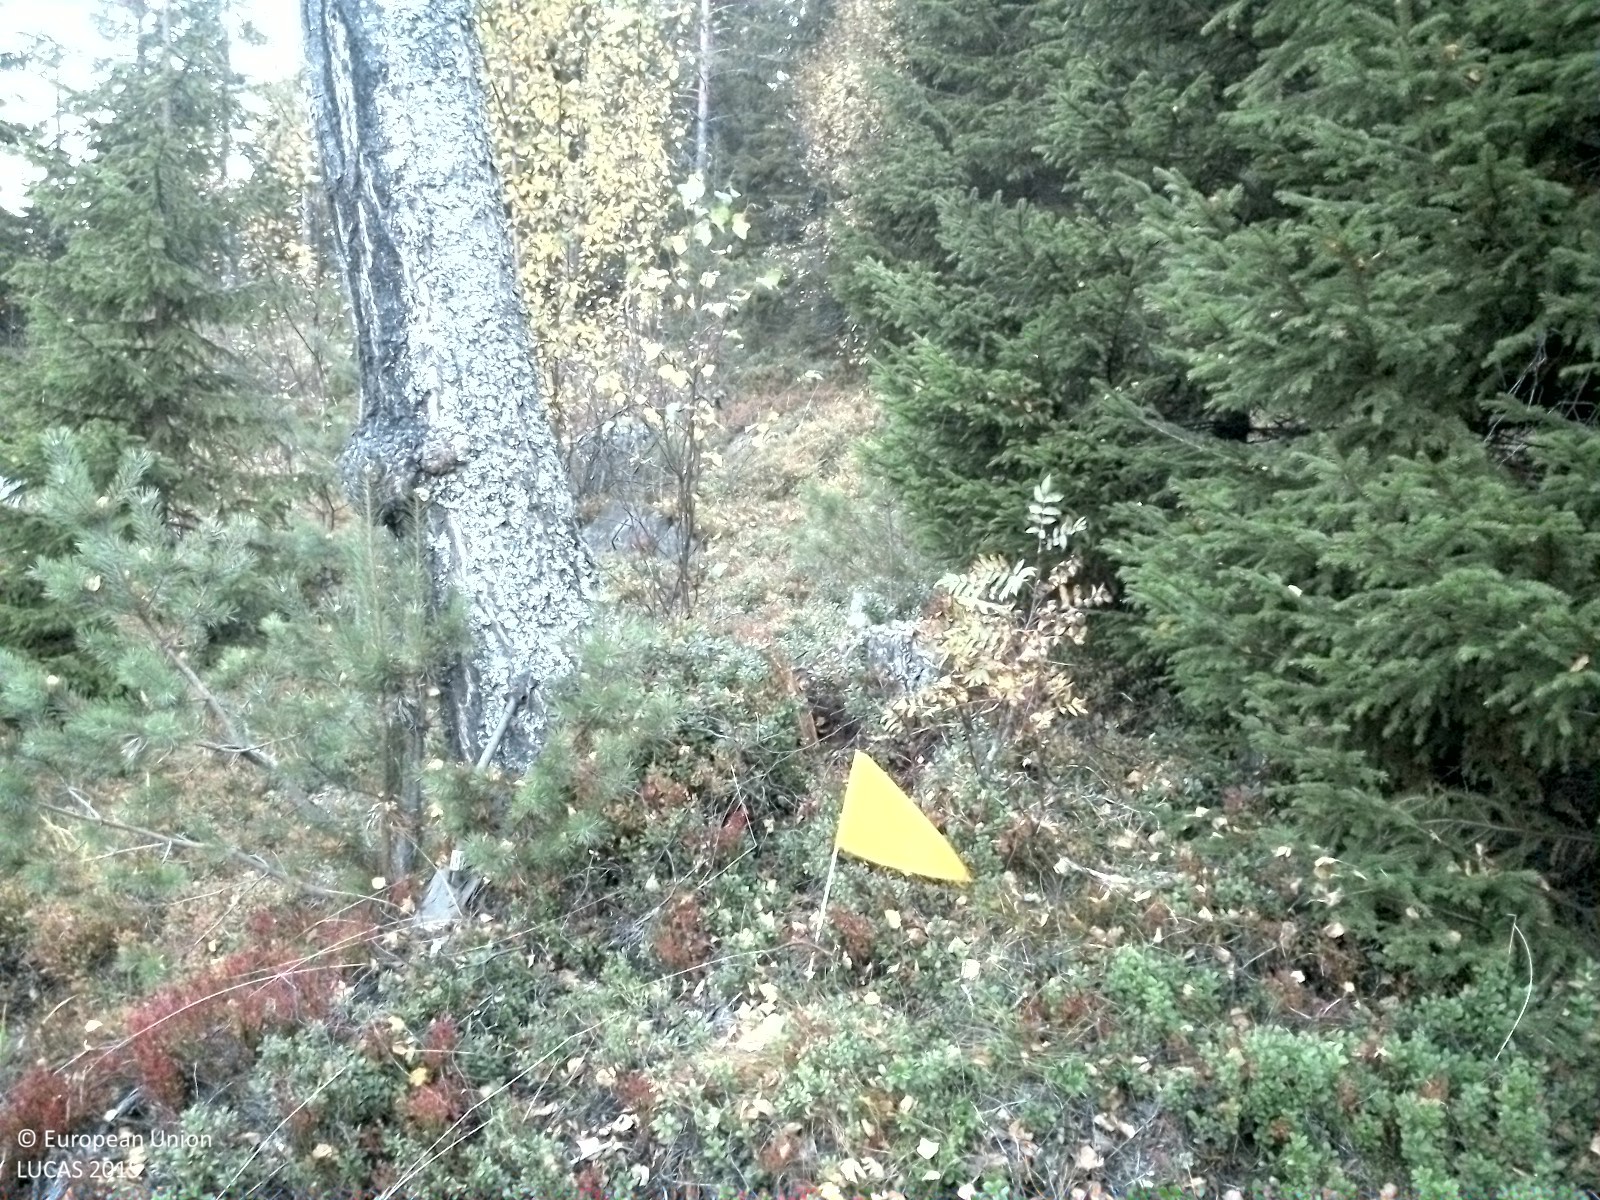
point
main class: Woodland
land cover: Spruce dominated mixed woodland
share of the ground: 50 - 75 %
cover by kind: coniferous forest trees 35 %, herbaceous plants 30 %, shrubs 20 %, broadleaved forest trees 15 %
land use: Forestry
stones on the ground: < 10 %
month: September
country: SE
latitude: 62.4471
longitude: 17.0529
